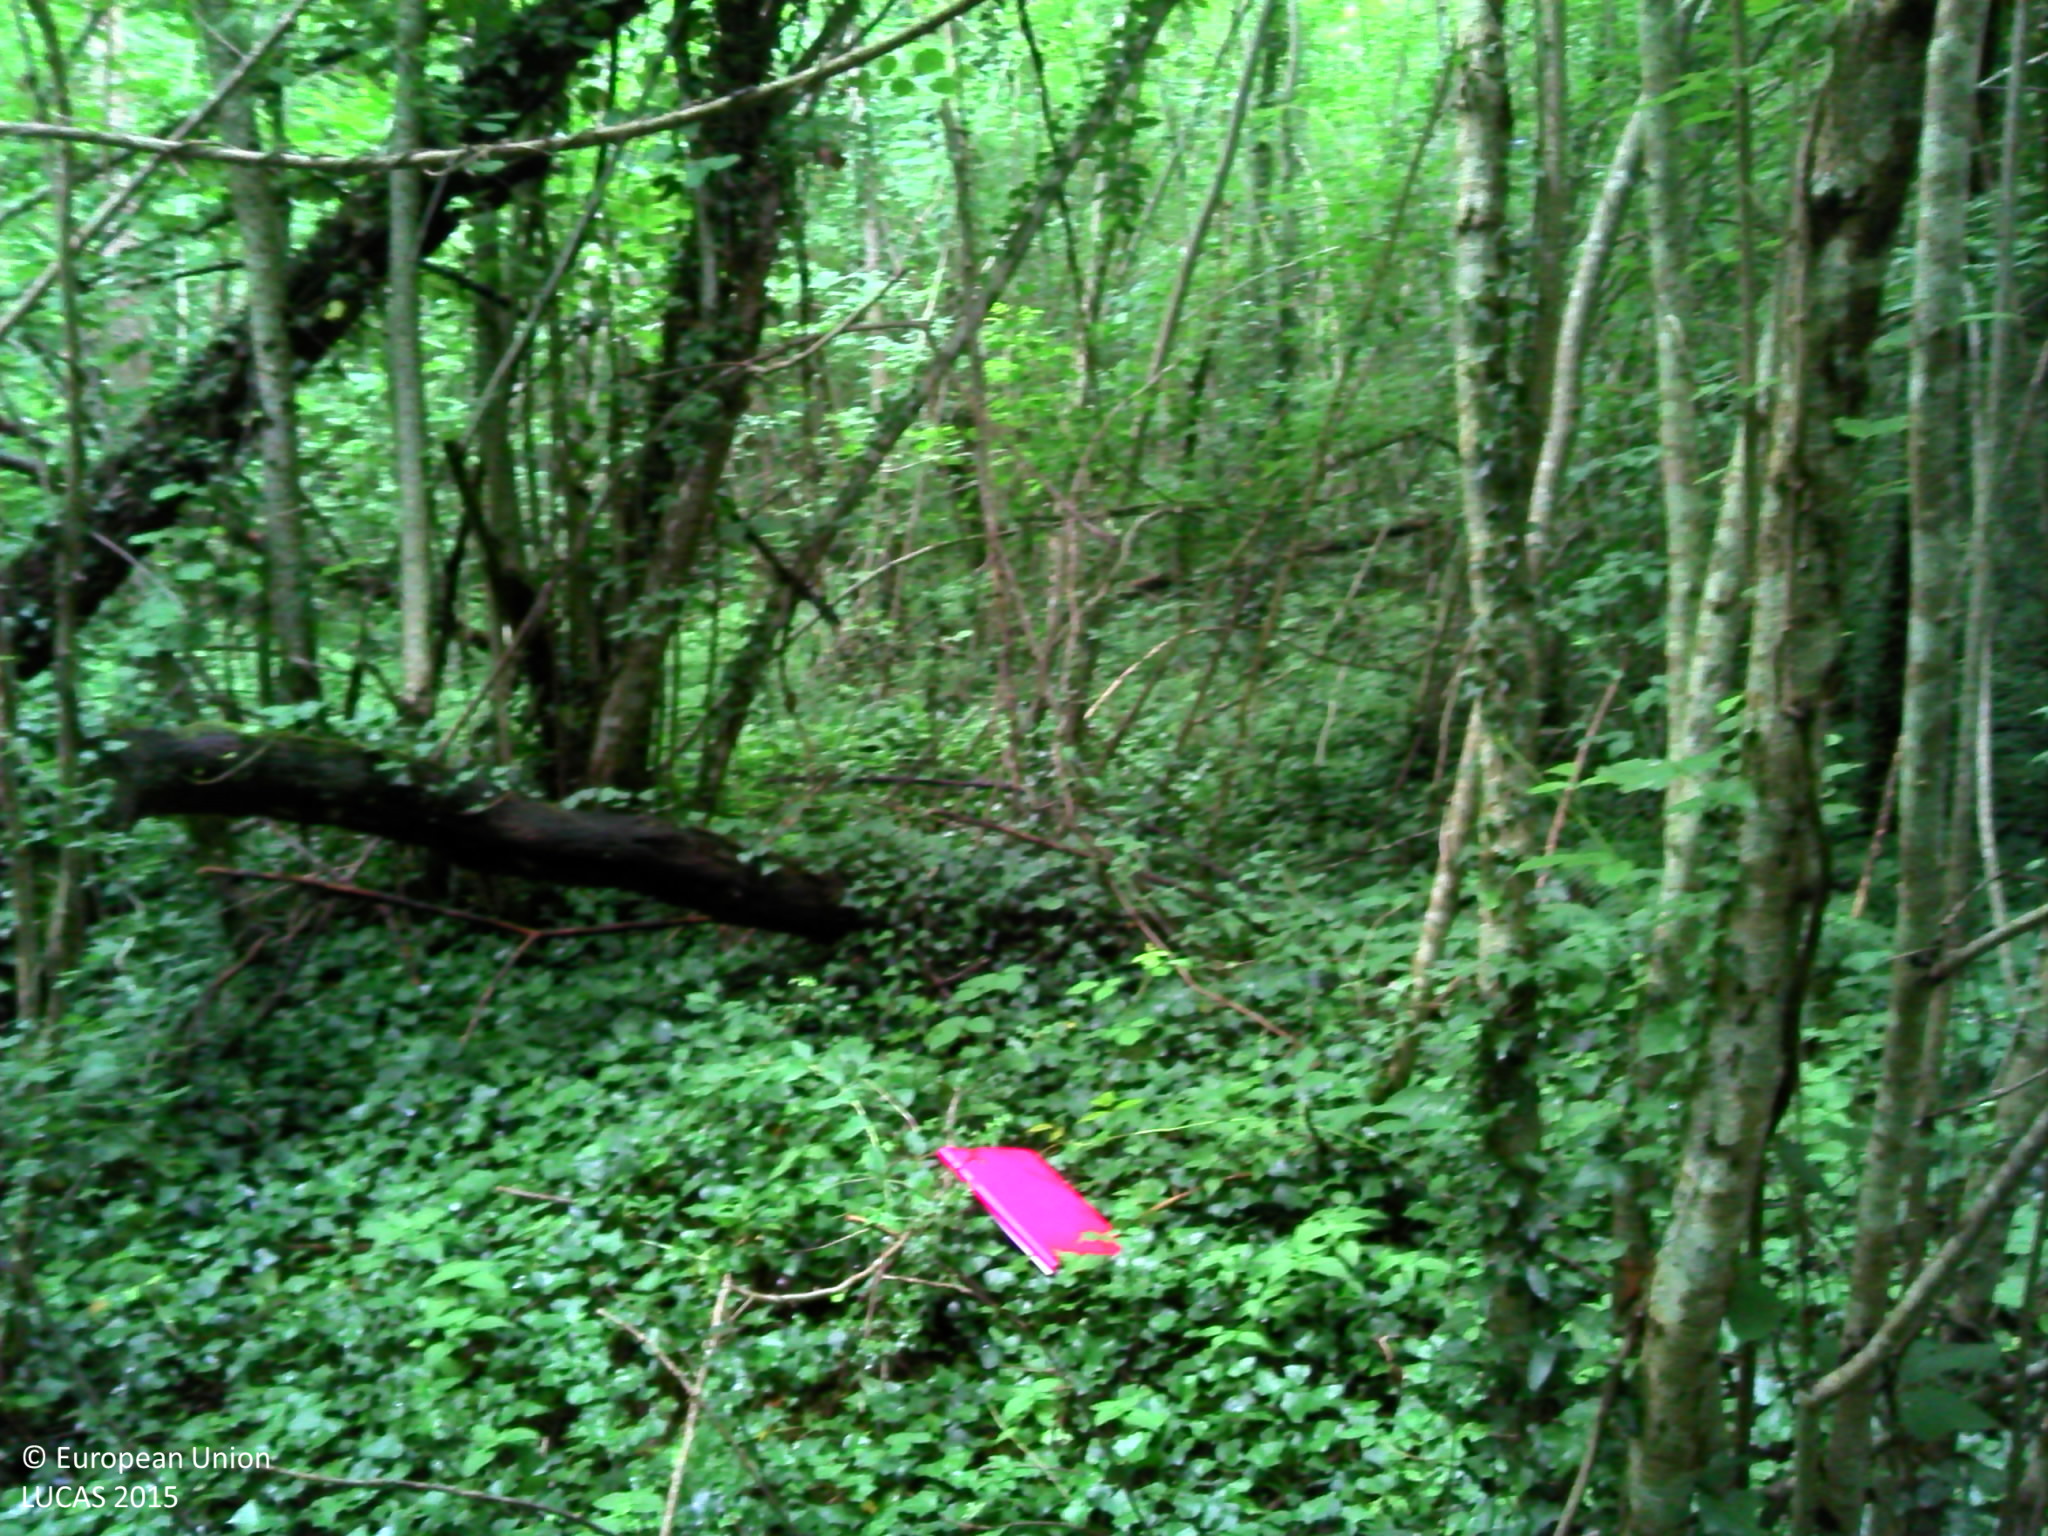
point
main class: Woodland
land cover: Broadleaved woodland
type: floodplain forest
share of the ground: > 75 %
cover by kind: broadleaved forest trees 80 %, herbaceous plants 20 %
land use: Forestry
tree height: > 5 m
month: June
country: FR
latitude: 43.2178
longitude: -0.3094
